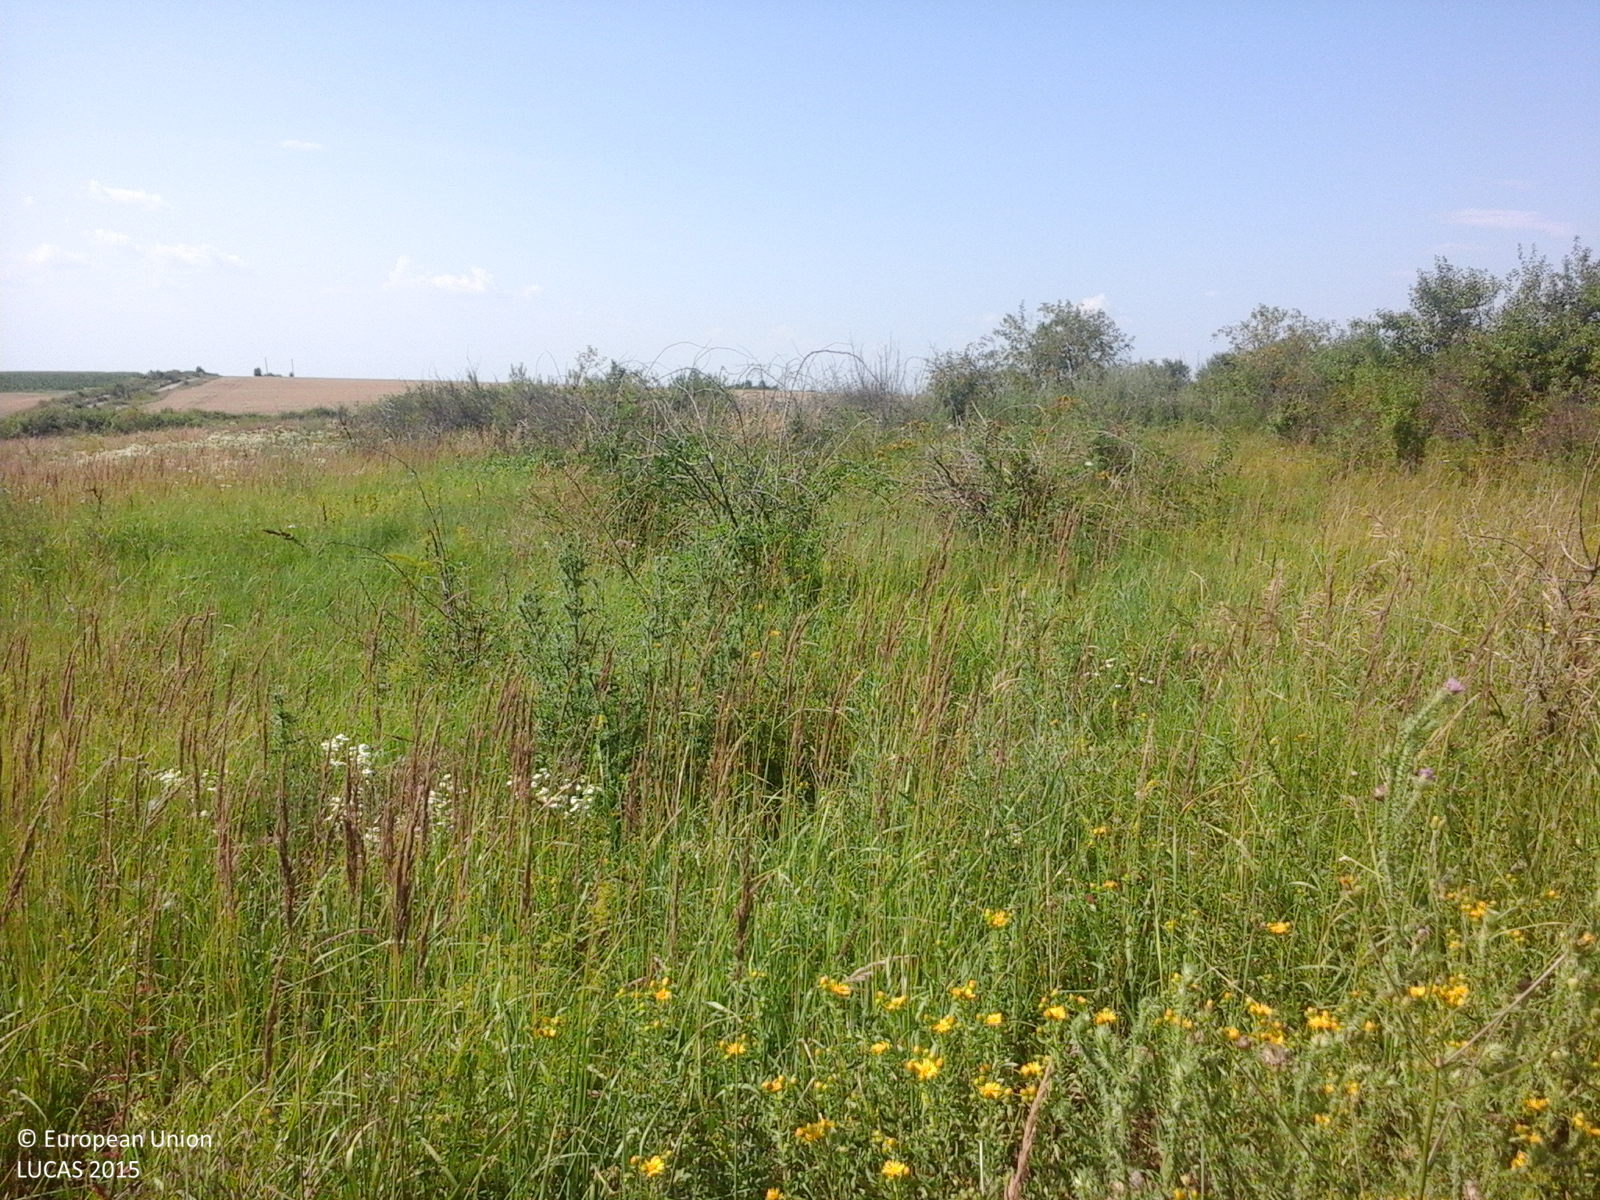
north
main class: Grassland
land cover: Grassland with sparse tree/shrub cover
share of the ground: > 75 %
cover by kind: herbaceous plants 85 %, shrubs 10 %, broadleaved forest trees 5 %
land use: Agriculture (excluding fallow land and kitchen gardens)
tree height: < 5 m
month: July
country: RO
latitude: 44.5678
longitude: 24.3861
